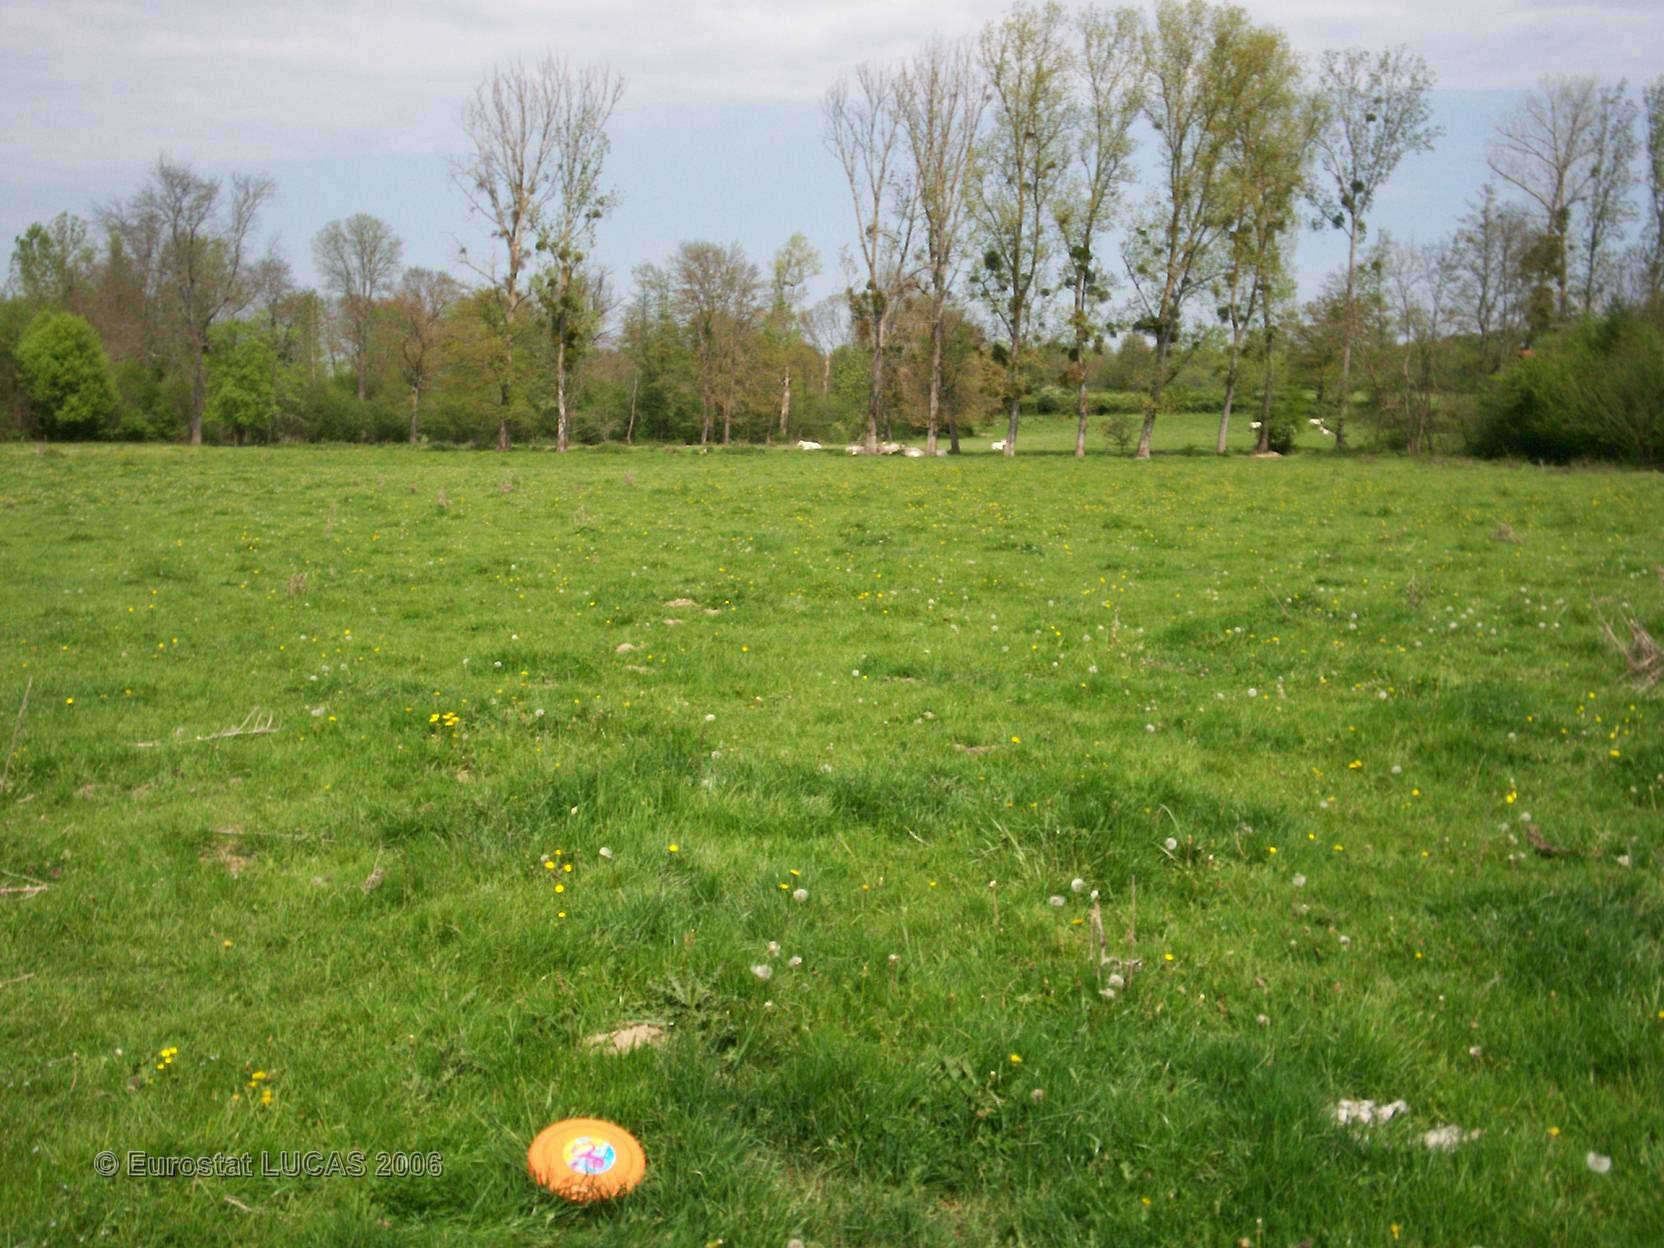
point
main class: Grassland
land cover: Grassland without tree/shrub cover
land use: Agriculture (excluding fallow land and kitchen gardens)
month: May
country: FR
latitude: 45.8282
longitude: 4.1195
